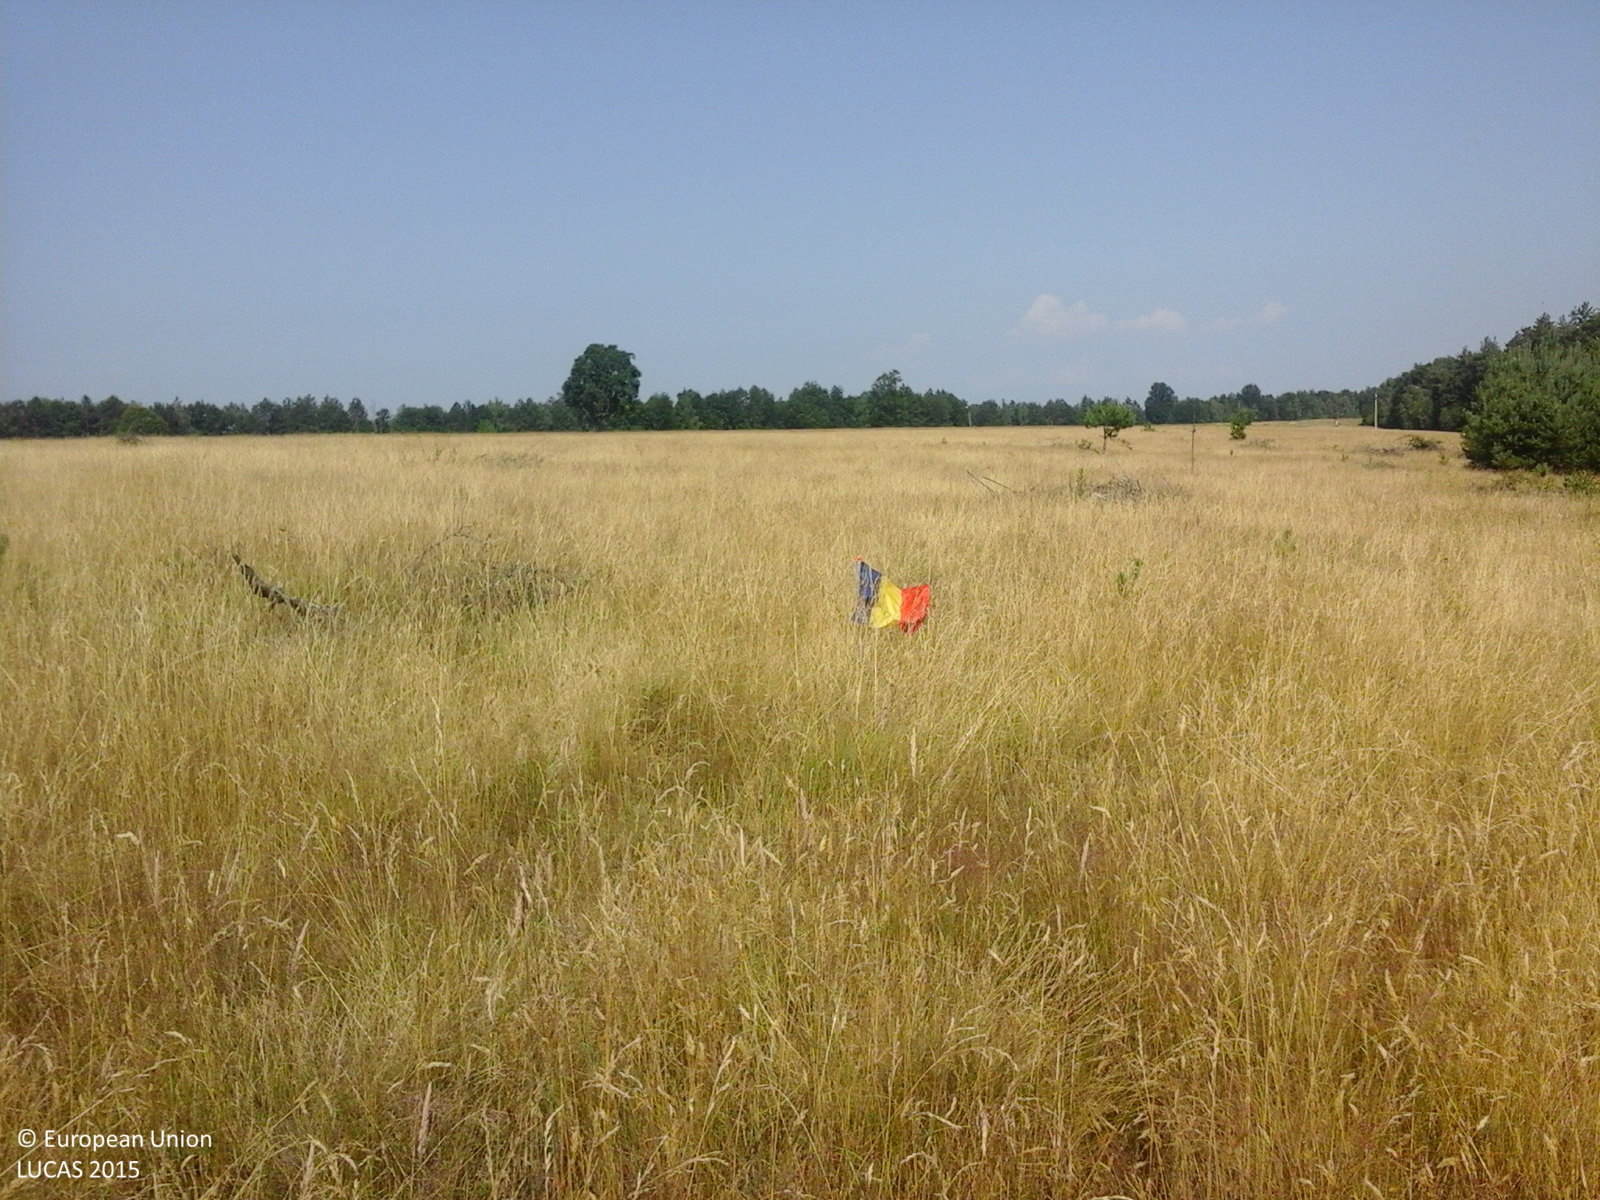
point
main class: Grassland
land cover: Grassland with sparse tree/shrub cover
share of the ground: > 75 %
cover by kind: herbaceous plants 85 %, shrubs 10 %, broadleaved forest trees 5 %
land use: Agriculture (excluding fallow land and kitchen gardens)
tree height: < 5 m
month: July
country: RO
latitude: 45.0302
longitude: 24.6108
